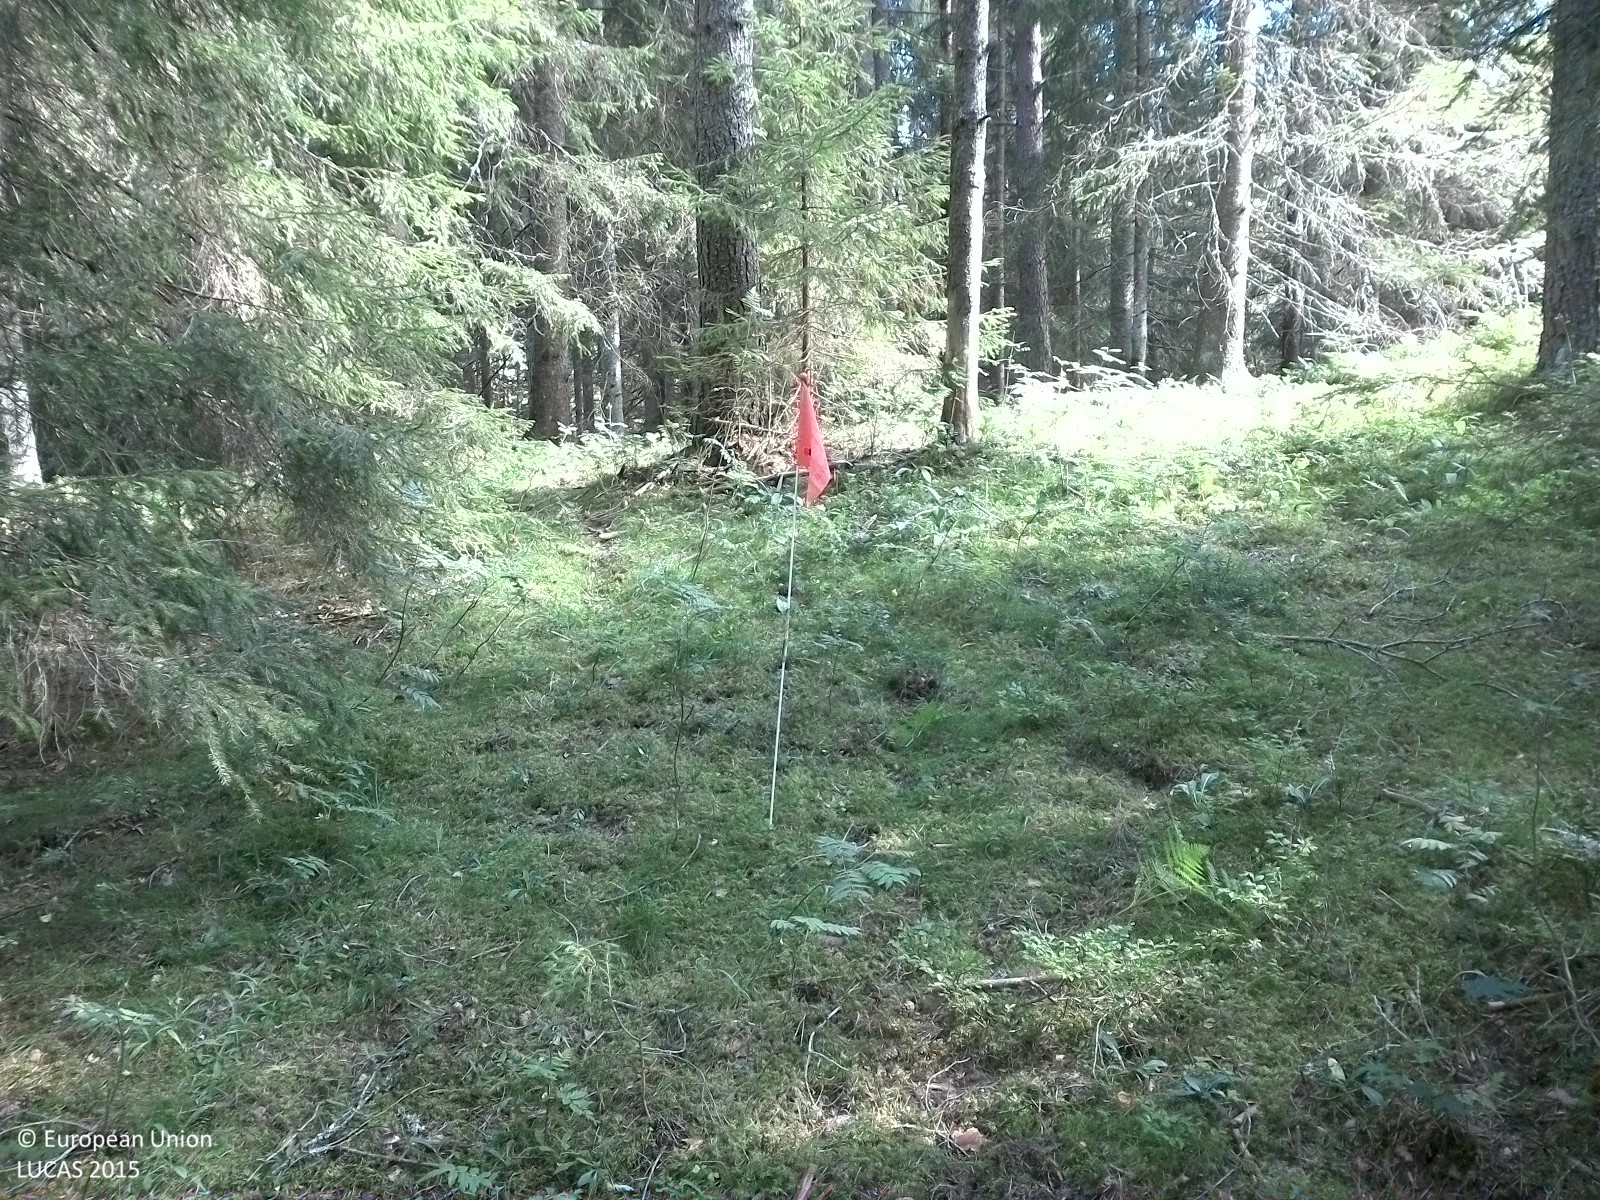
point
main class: Woodland
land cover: Other mixed woodland
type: boreal forest
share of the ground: 50 - 75 %
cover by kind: coniferous forest trees 35 %, lichens and mosses 30 %, broadleaved forest trees 20 %, herbaceous plants 15 %
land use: Forestry
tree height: > 5 m
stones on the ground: < 10 %
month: August
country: SE
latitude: 59.2175
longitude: 14.7391
